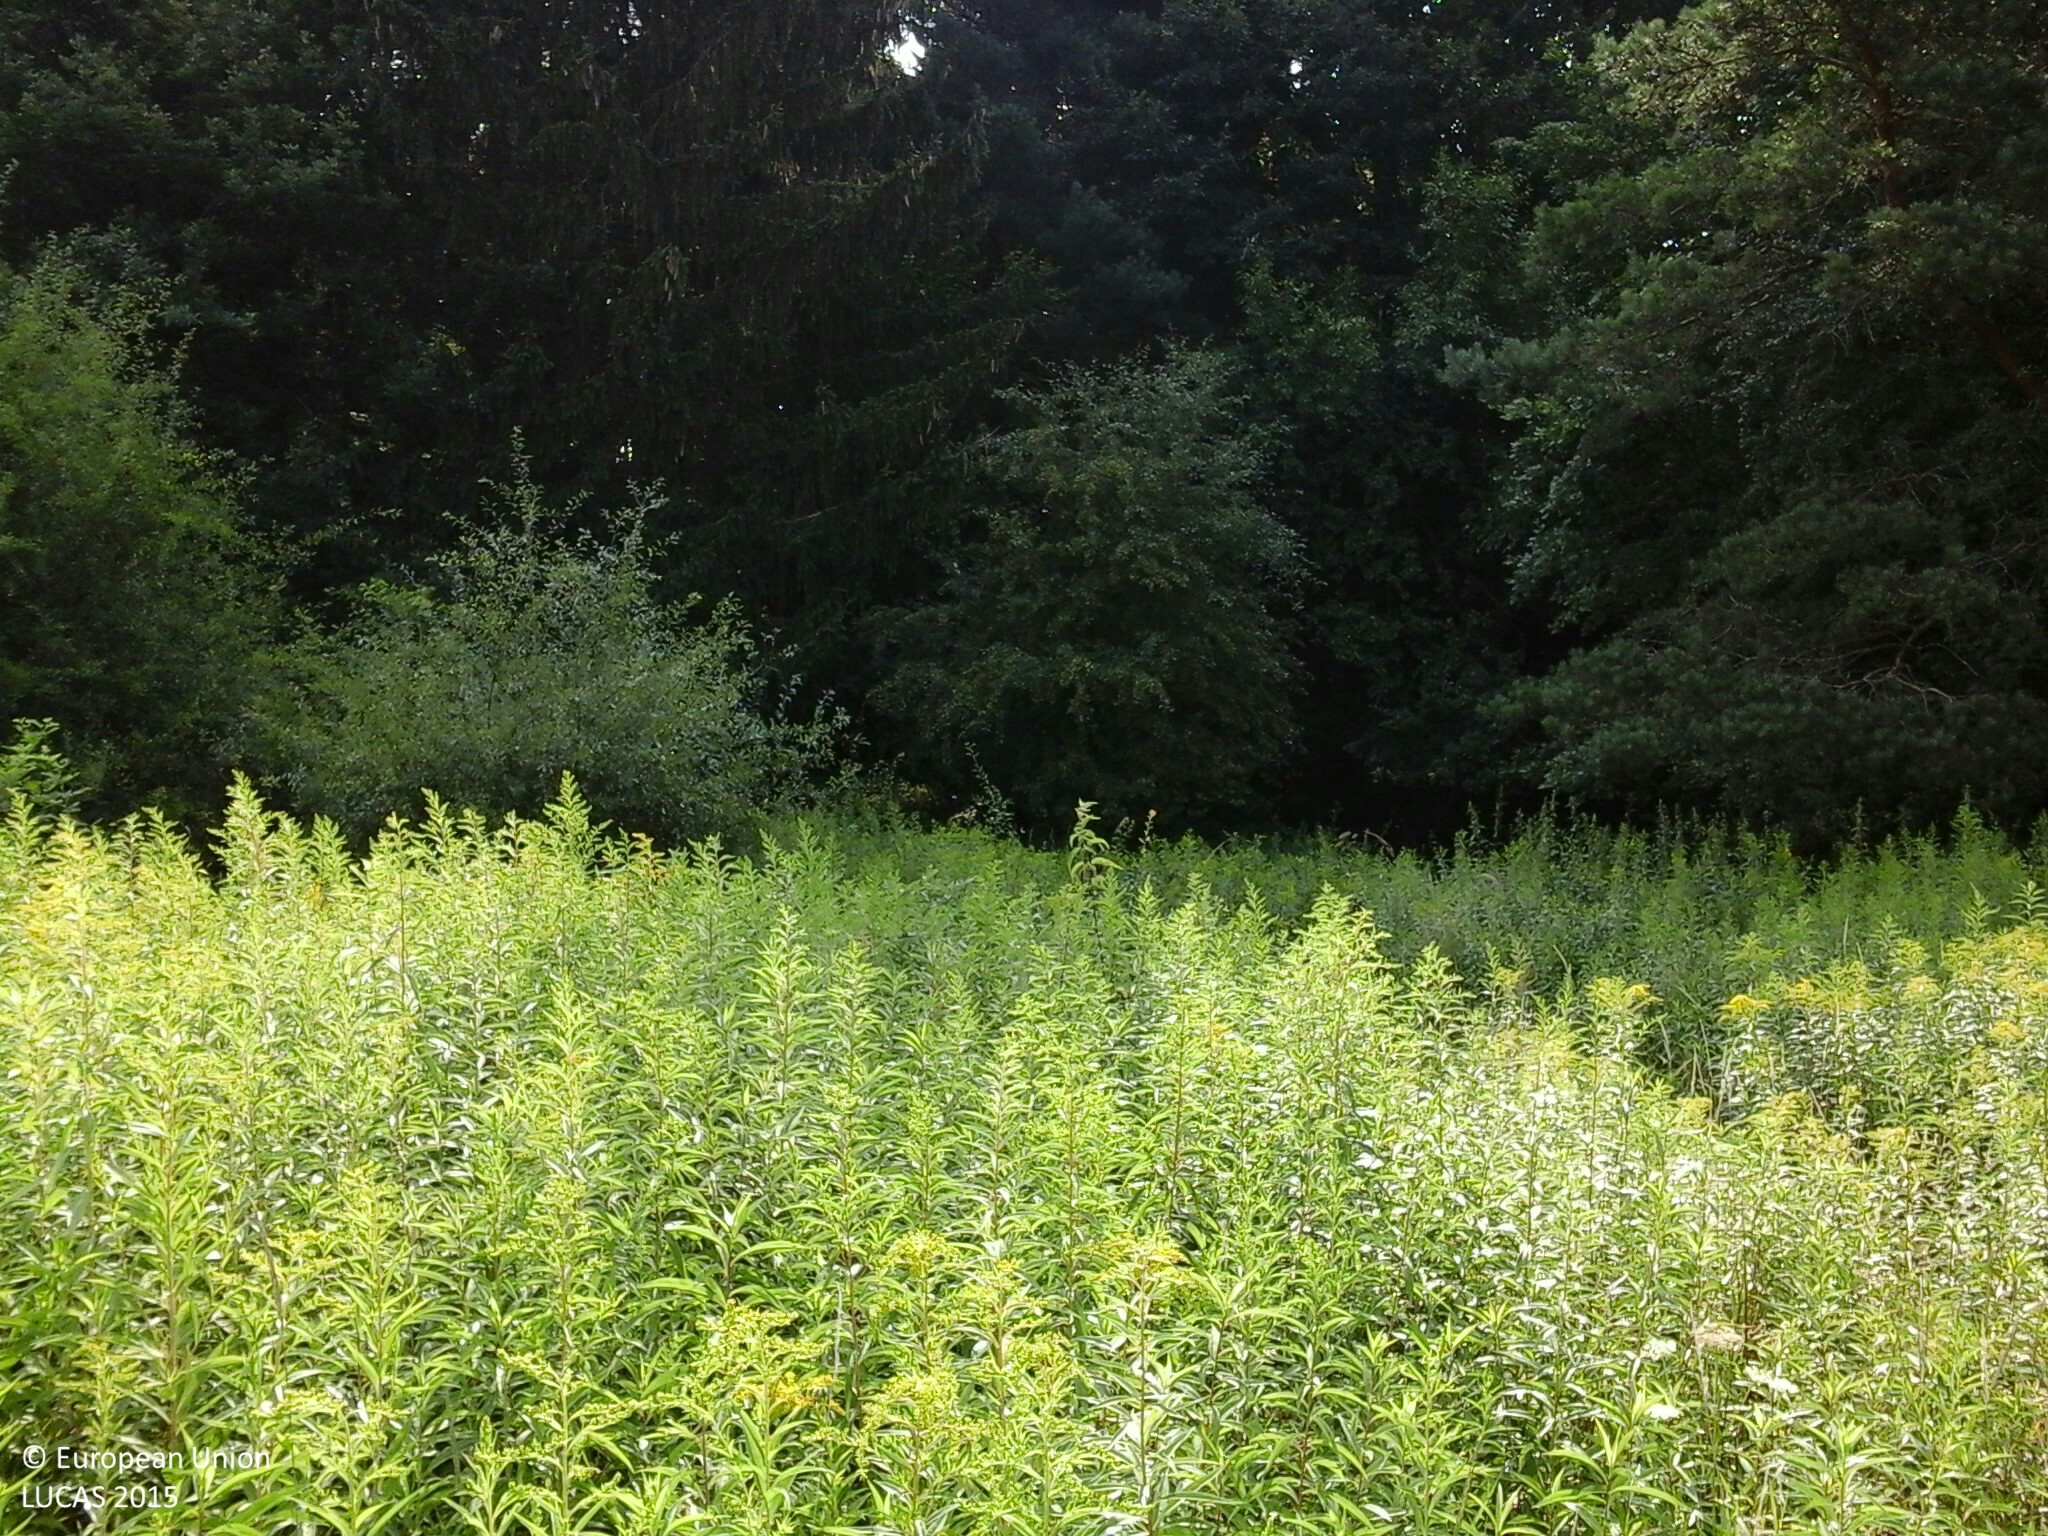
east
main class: Grassland
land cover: Grassland without tree/shrub cover
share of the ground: > 75 %
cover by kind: herbaceous plants 100 %
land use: Abandoned areas
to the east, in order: Grassland without tree/shrub cover; Pine dominated coniferous woodland; Tracks; Pine dominated coniferous woodland; Tracks; Pine dominated coniferous woodland; Tracks; Pine dominated coniferous woodland; Broadleaved woodland
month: July
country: HU
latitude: 46.8435
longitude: 16.4404
